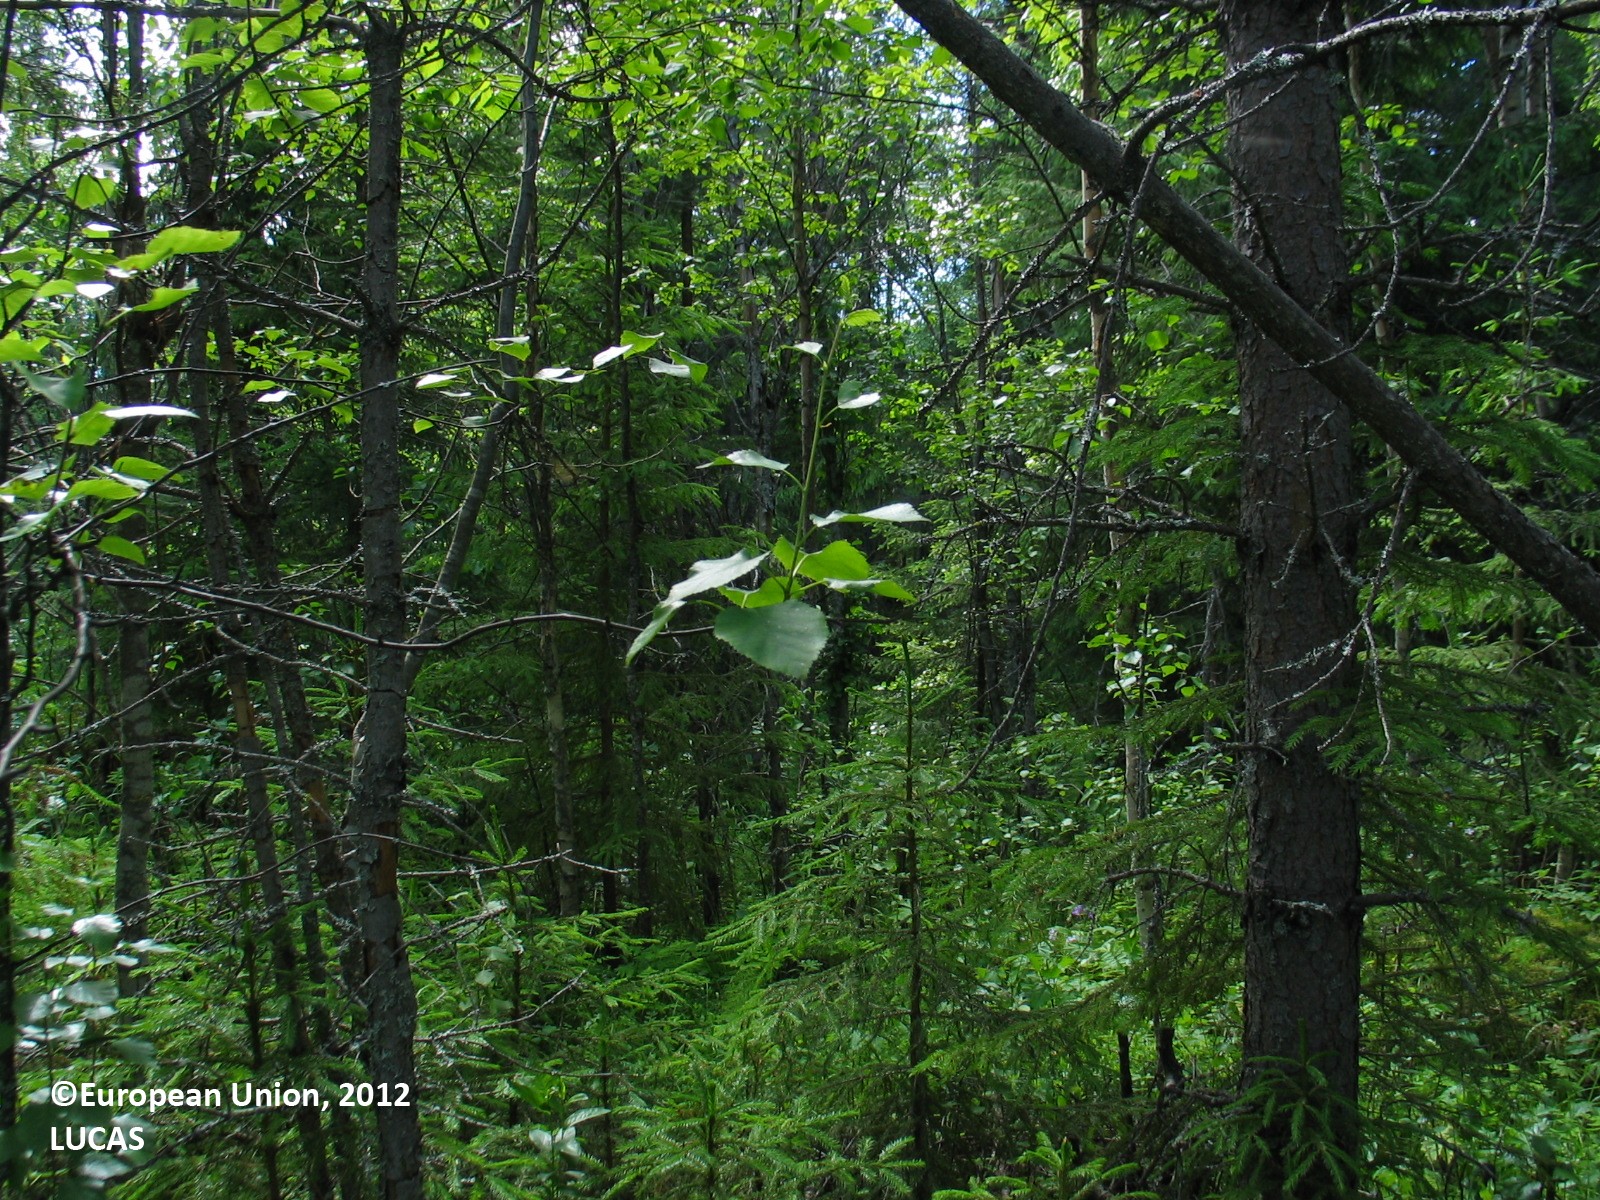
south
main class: Woodland
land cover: Other mixed woodland
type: boreal forest
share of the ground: > 75 %
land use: Forestry
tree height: > 5 m
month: July
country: FI
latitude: 64.7214
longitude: 26.5900
